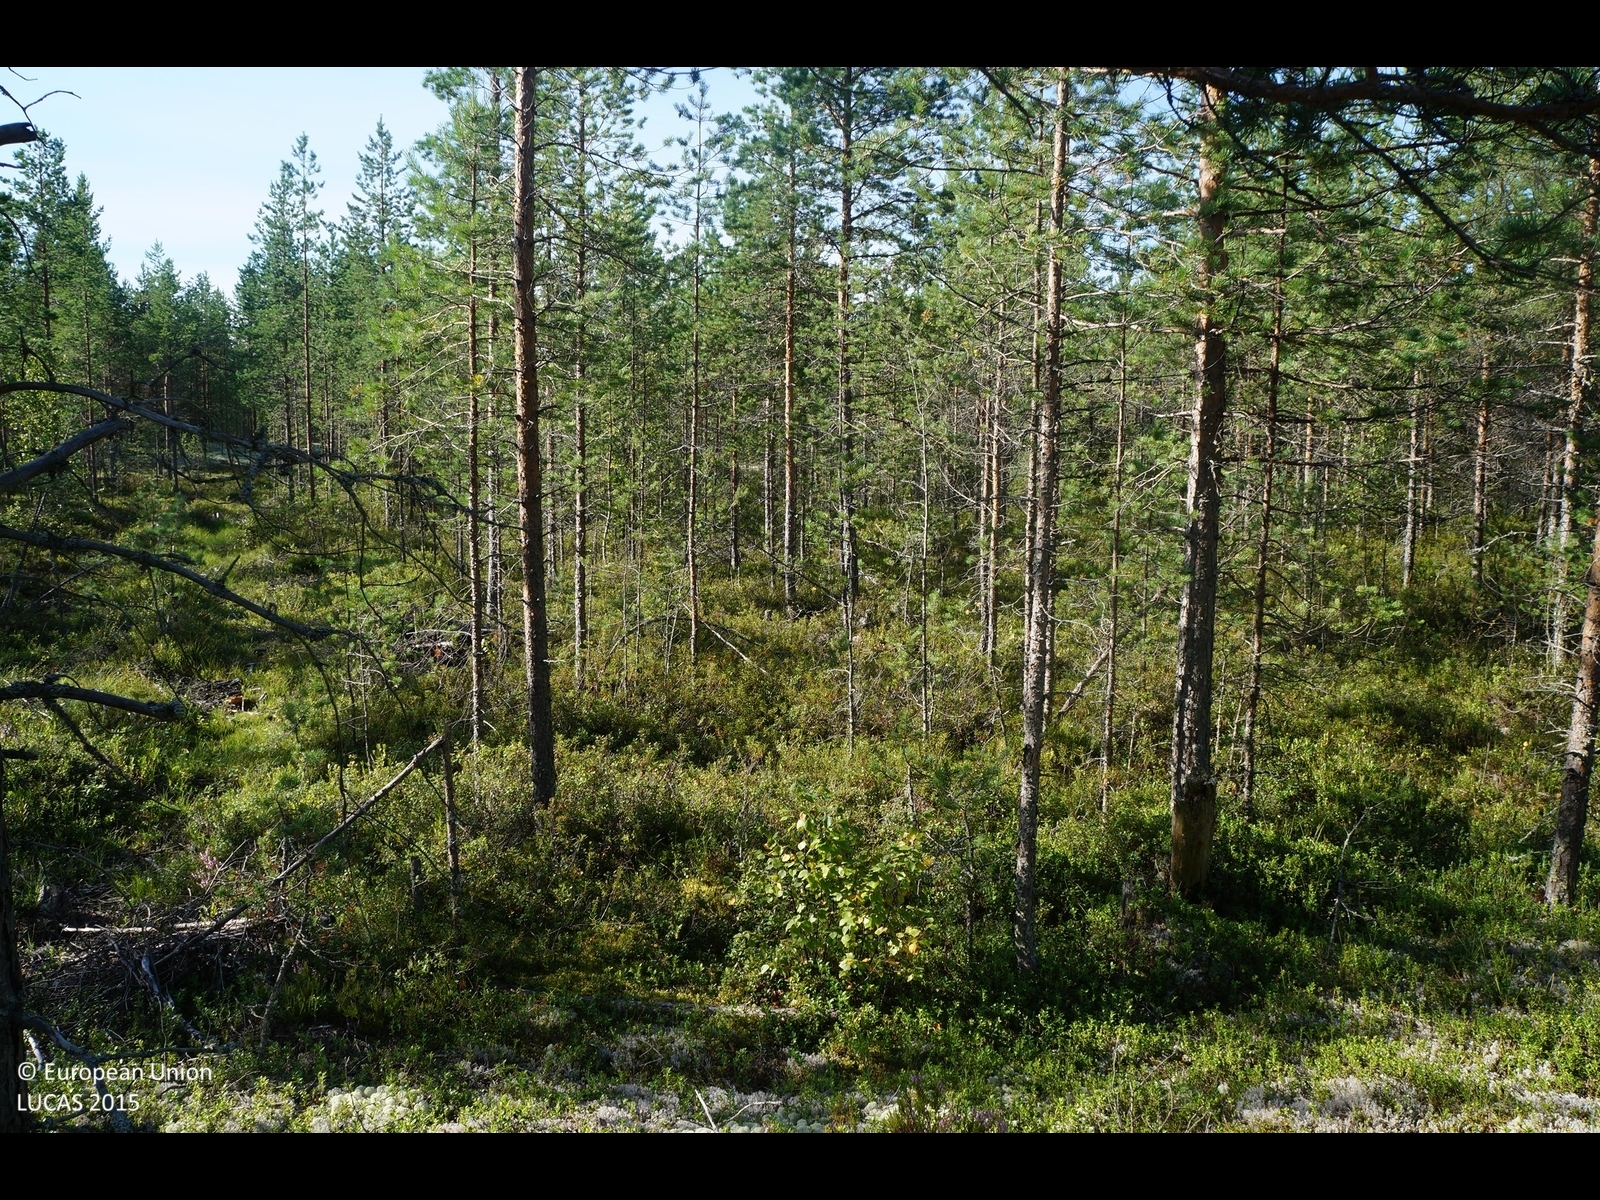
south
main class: Woodland
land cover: Pine dominated coniferous woodland
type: boreal forest
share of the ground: 25 - 50 %
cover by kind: coniferous forest trees 40 %, shrubs 30 %, lichens and mosses 30 %
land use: Forestry
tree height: > 5 m
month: August
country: FI
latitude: 64.8483
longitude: 24.9402
